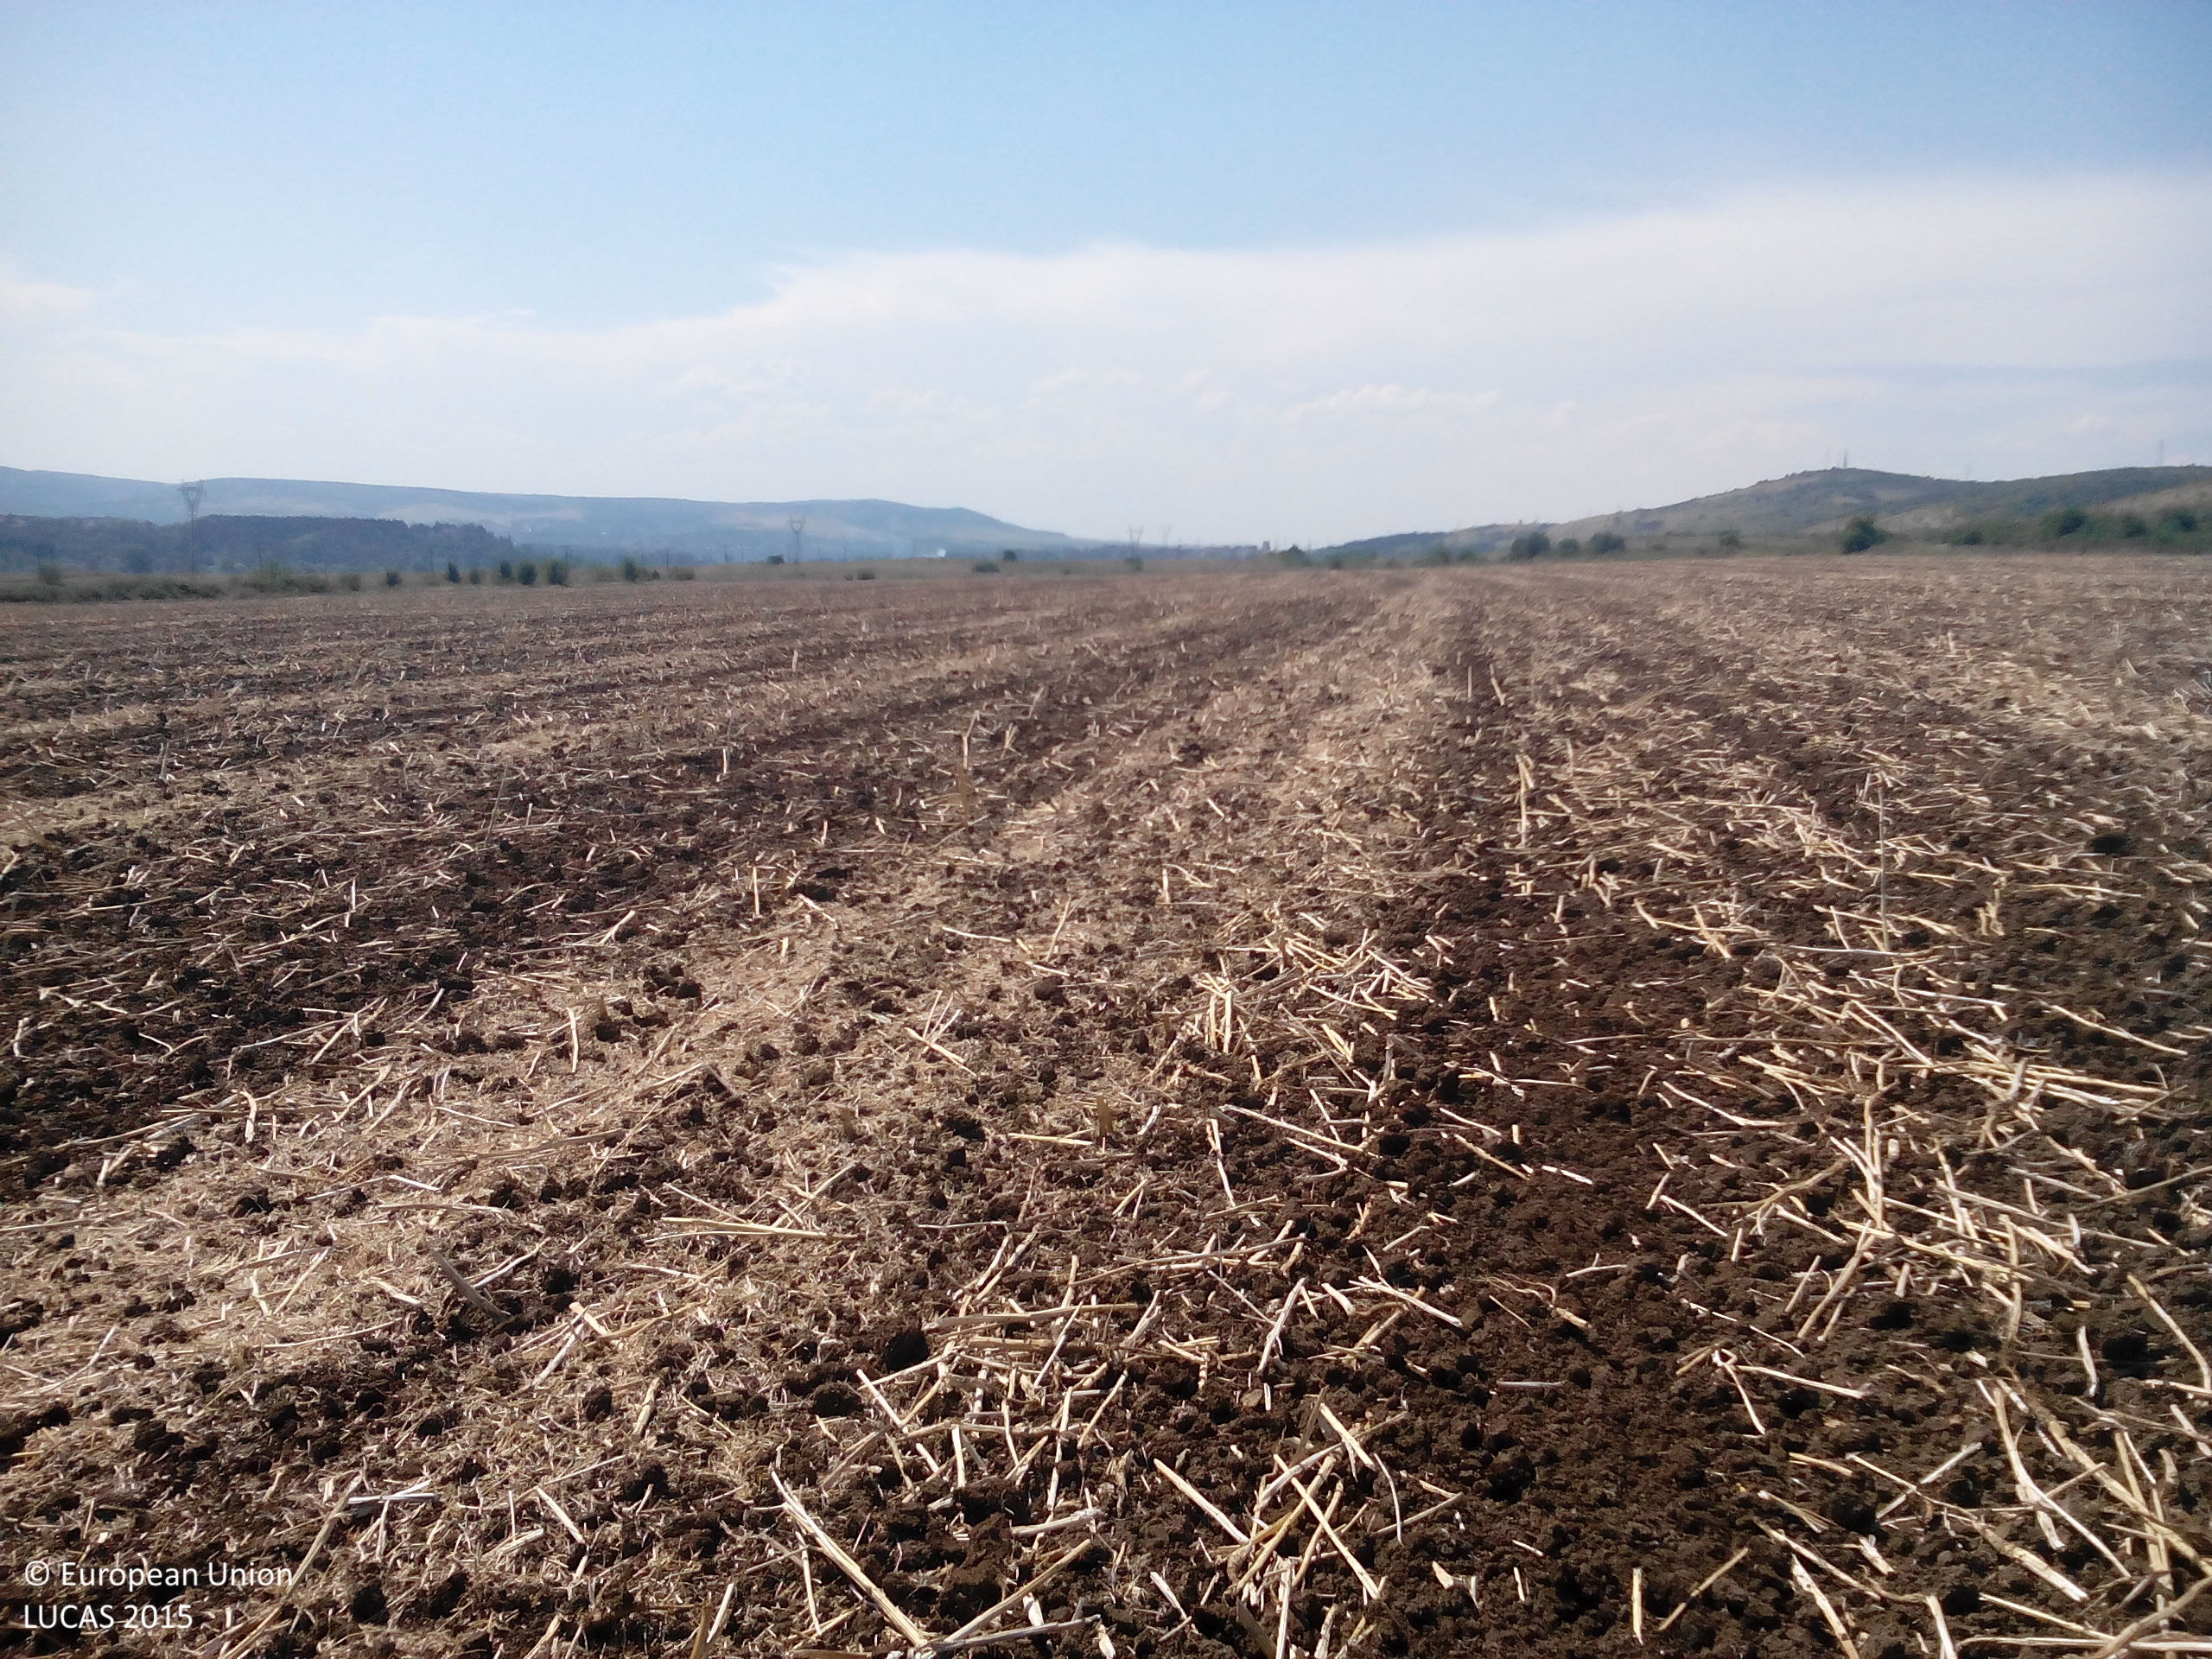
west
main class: Cropland
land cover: Rape and turnip rape
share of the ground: < 10 %
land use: Agriculture (excluding fallow land and kitchen gardens)
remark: Harvested field
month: July
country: BG
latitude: 43.2886
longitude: 24.1150
